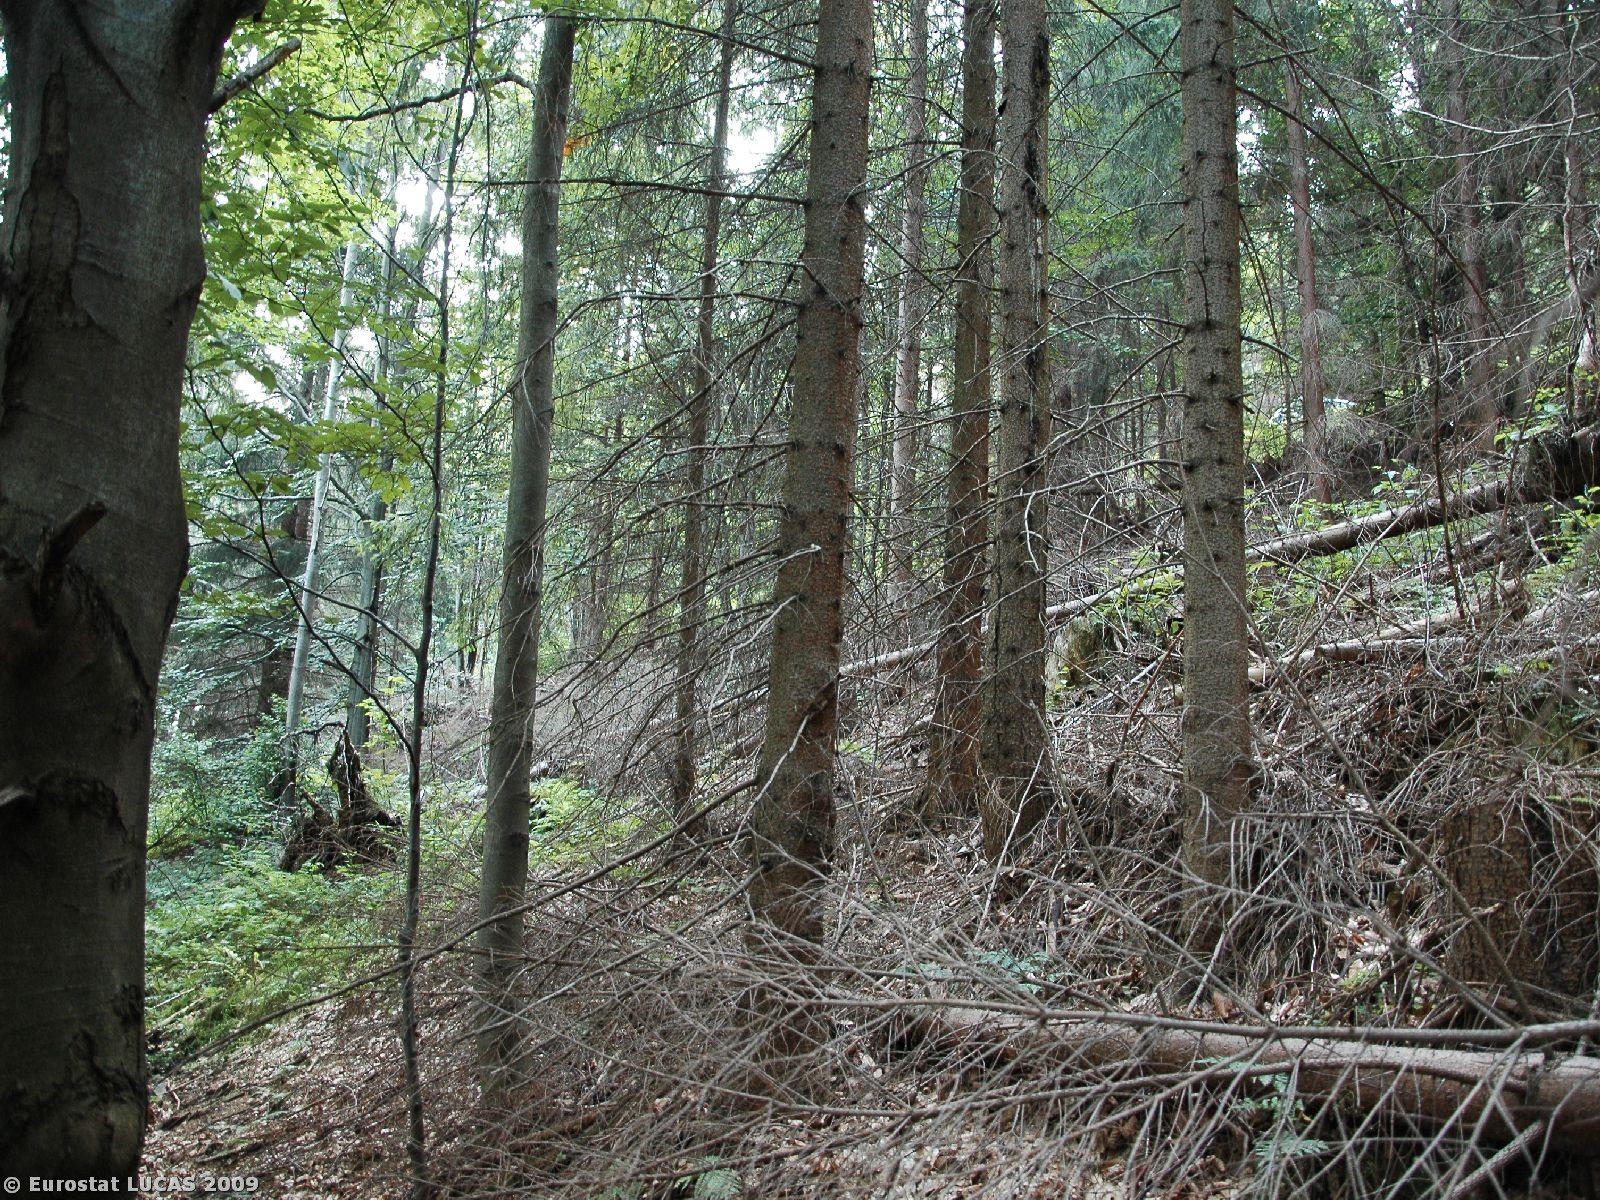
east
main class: Woodland
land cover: Mixed woodland
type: hemiboreal forest and nemoral coniferous forest and mixed broadleaved-coniferous forest
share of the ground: 50 - 75 %
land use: Forestry
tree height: > 5 m
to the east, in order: Mixed woodland; Tracks; Mixed woodland; Tracks; Mixed woodland; Tracks; Mixed woodland; Tracks; Spontaneously vegetated surfaces
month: August
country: PL
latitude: 49.4632
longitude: 19.0324
